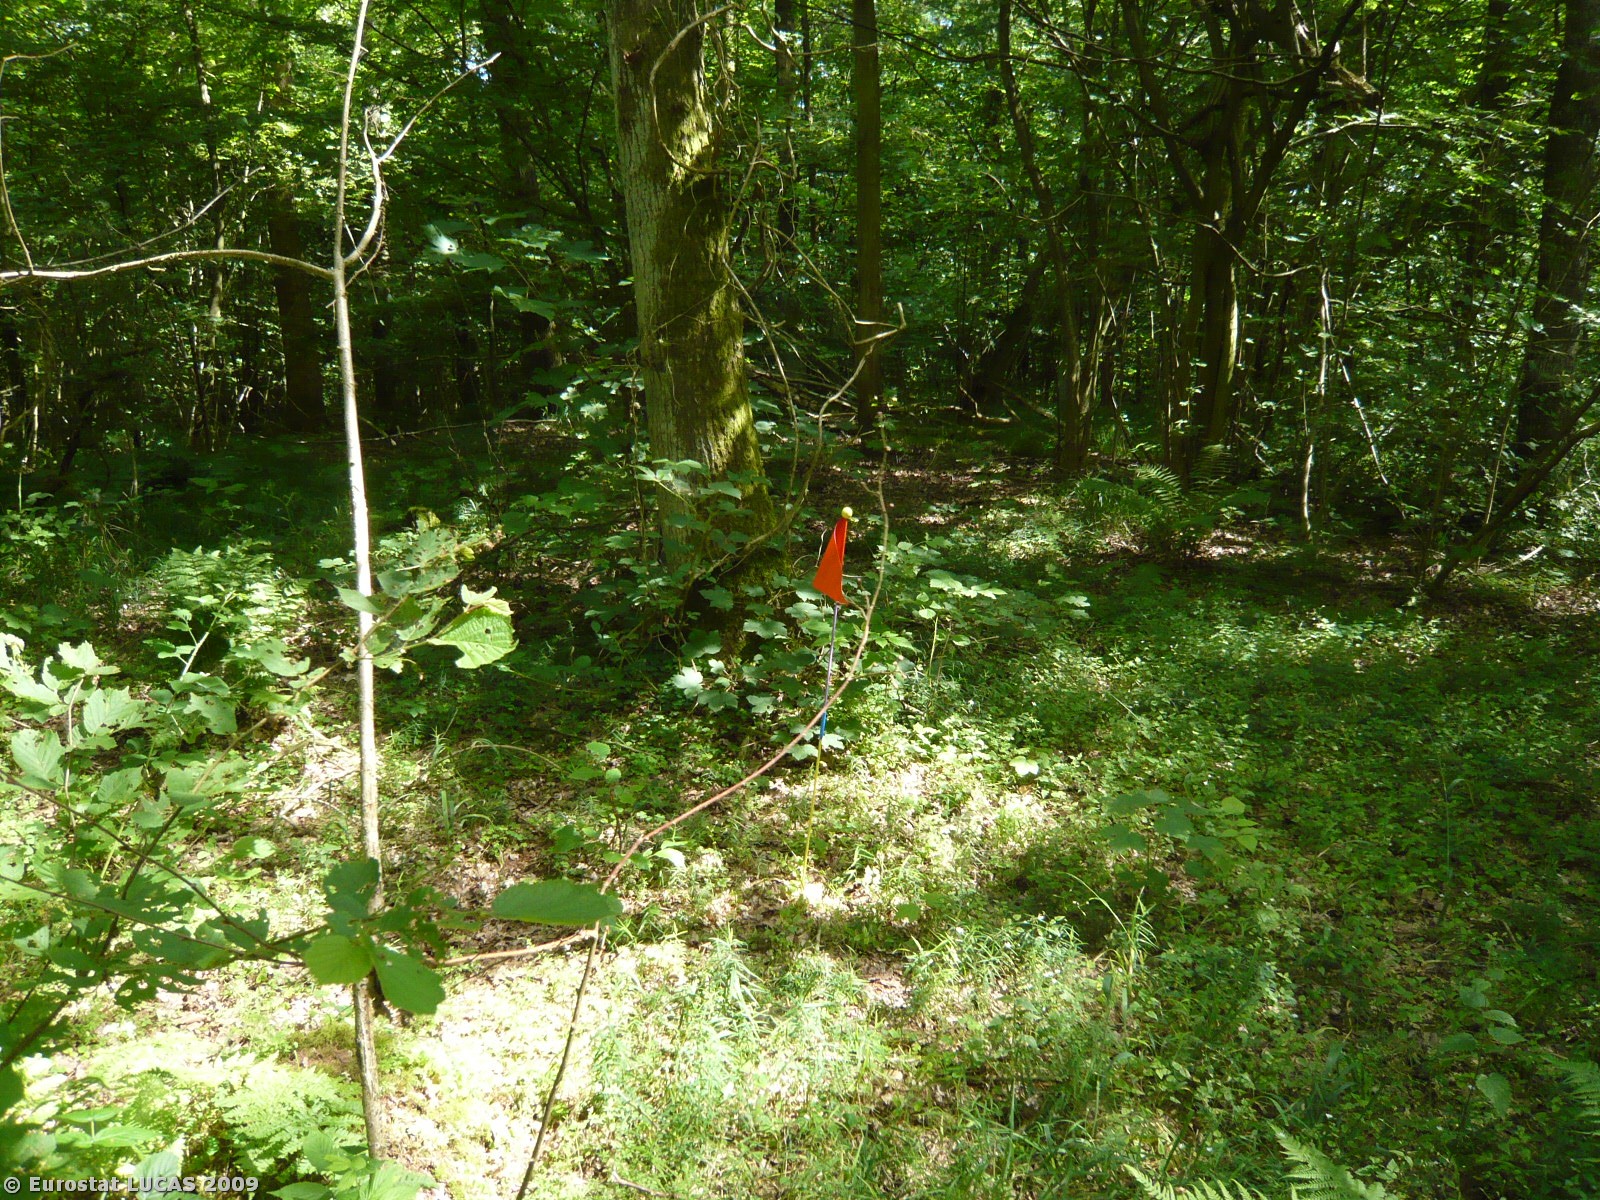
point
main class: Woodland
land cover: Broadleaved woodland
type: mesophytic deciduous forest
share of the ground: > 75 %
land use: Amenities, museums, leisure
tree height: > 5 m
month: June
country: DK
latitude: 55.1450
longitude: 10.2665
